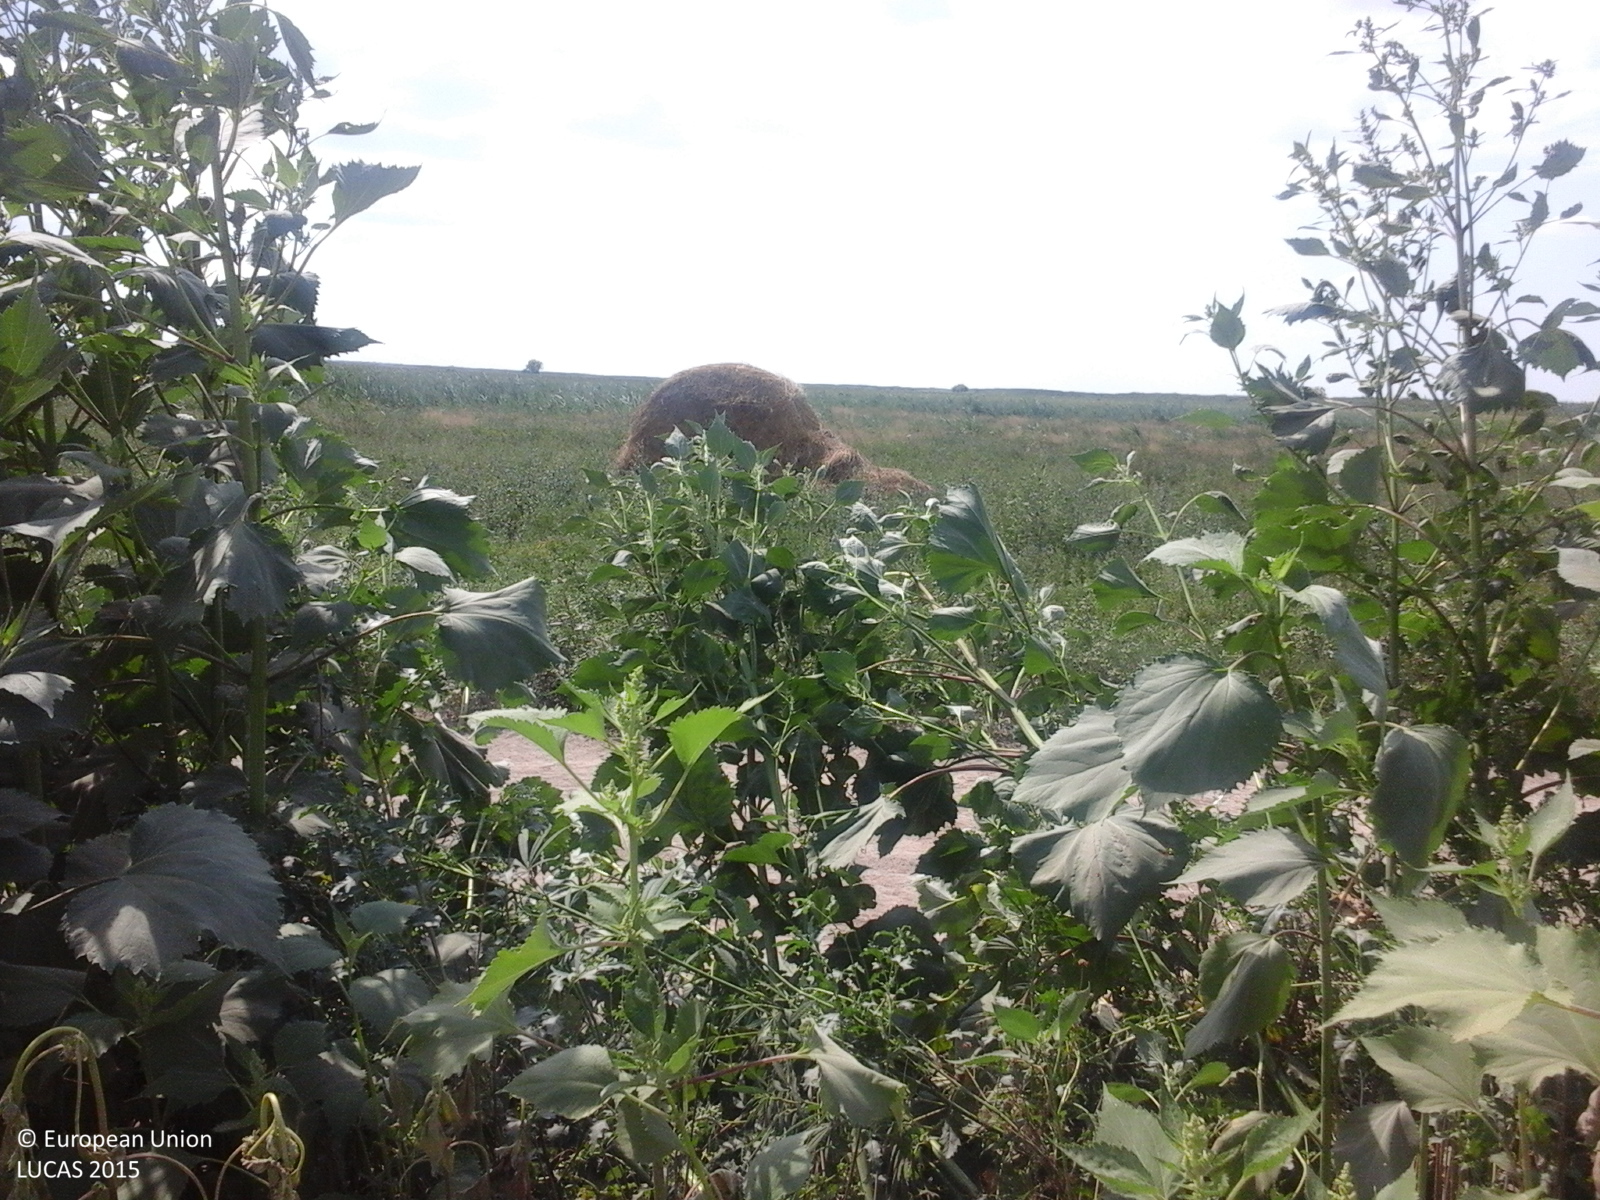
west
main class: Cropland
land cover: Barley
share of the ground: > 75 %
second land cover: Spontaneously vegetated surfaces
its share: > 75 %
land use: Agriculture (excluding fallow land and kitchen gardens)
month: August
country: RO
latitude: 45.2815
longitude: 29.1626
